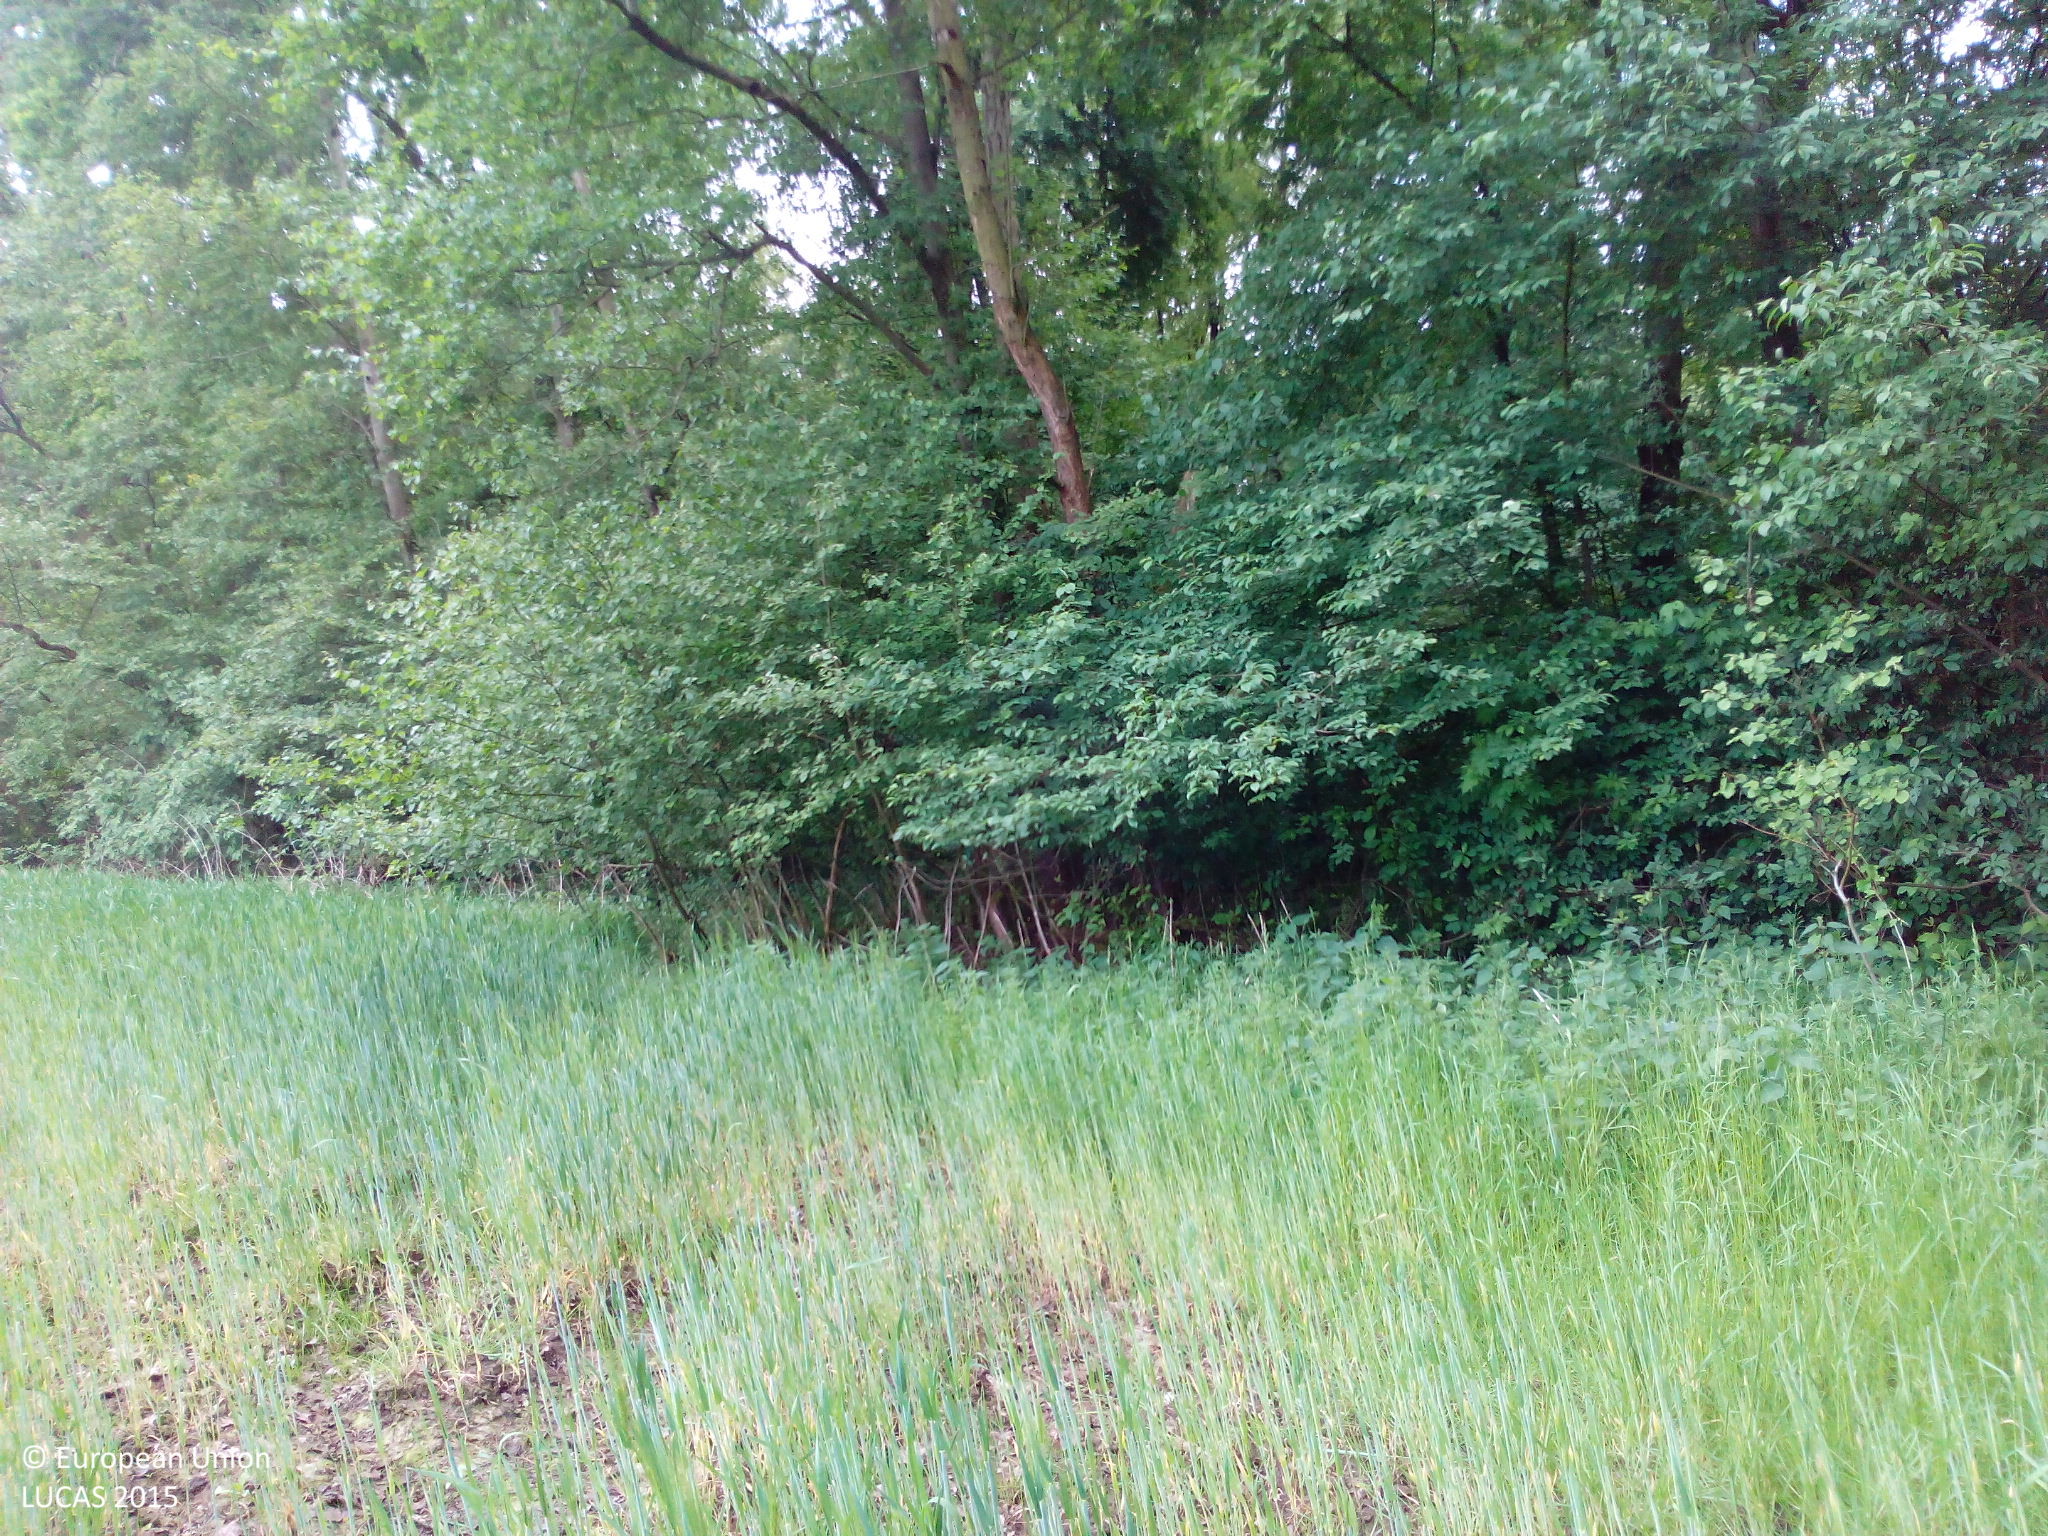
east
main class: Cropland
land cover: Barley
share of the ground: > 75 %
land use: Agriculture (excluding fallow land and kitchen gardens)
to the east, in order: Barley; Broadleaved woodland; Pine dominated mixed woodland; Tracks; Pine dominated mixed woodland; Grassland without tree/shrub cover
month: May
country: DE
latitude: 52.0191
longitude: 8.0040
